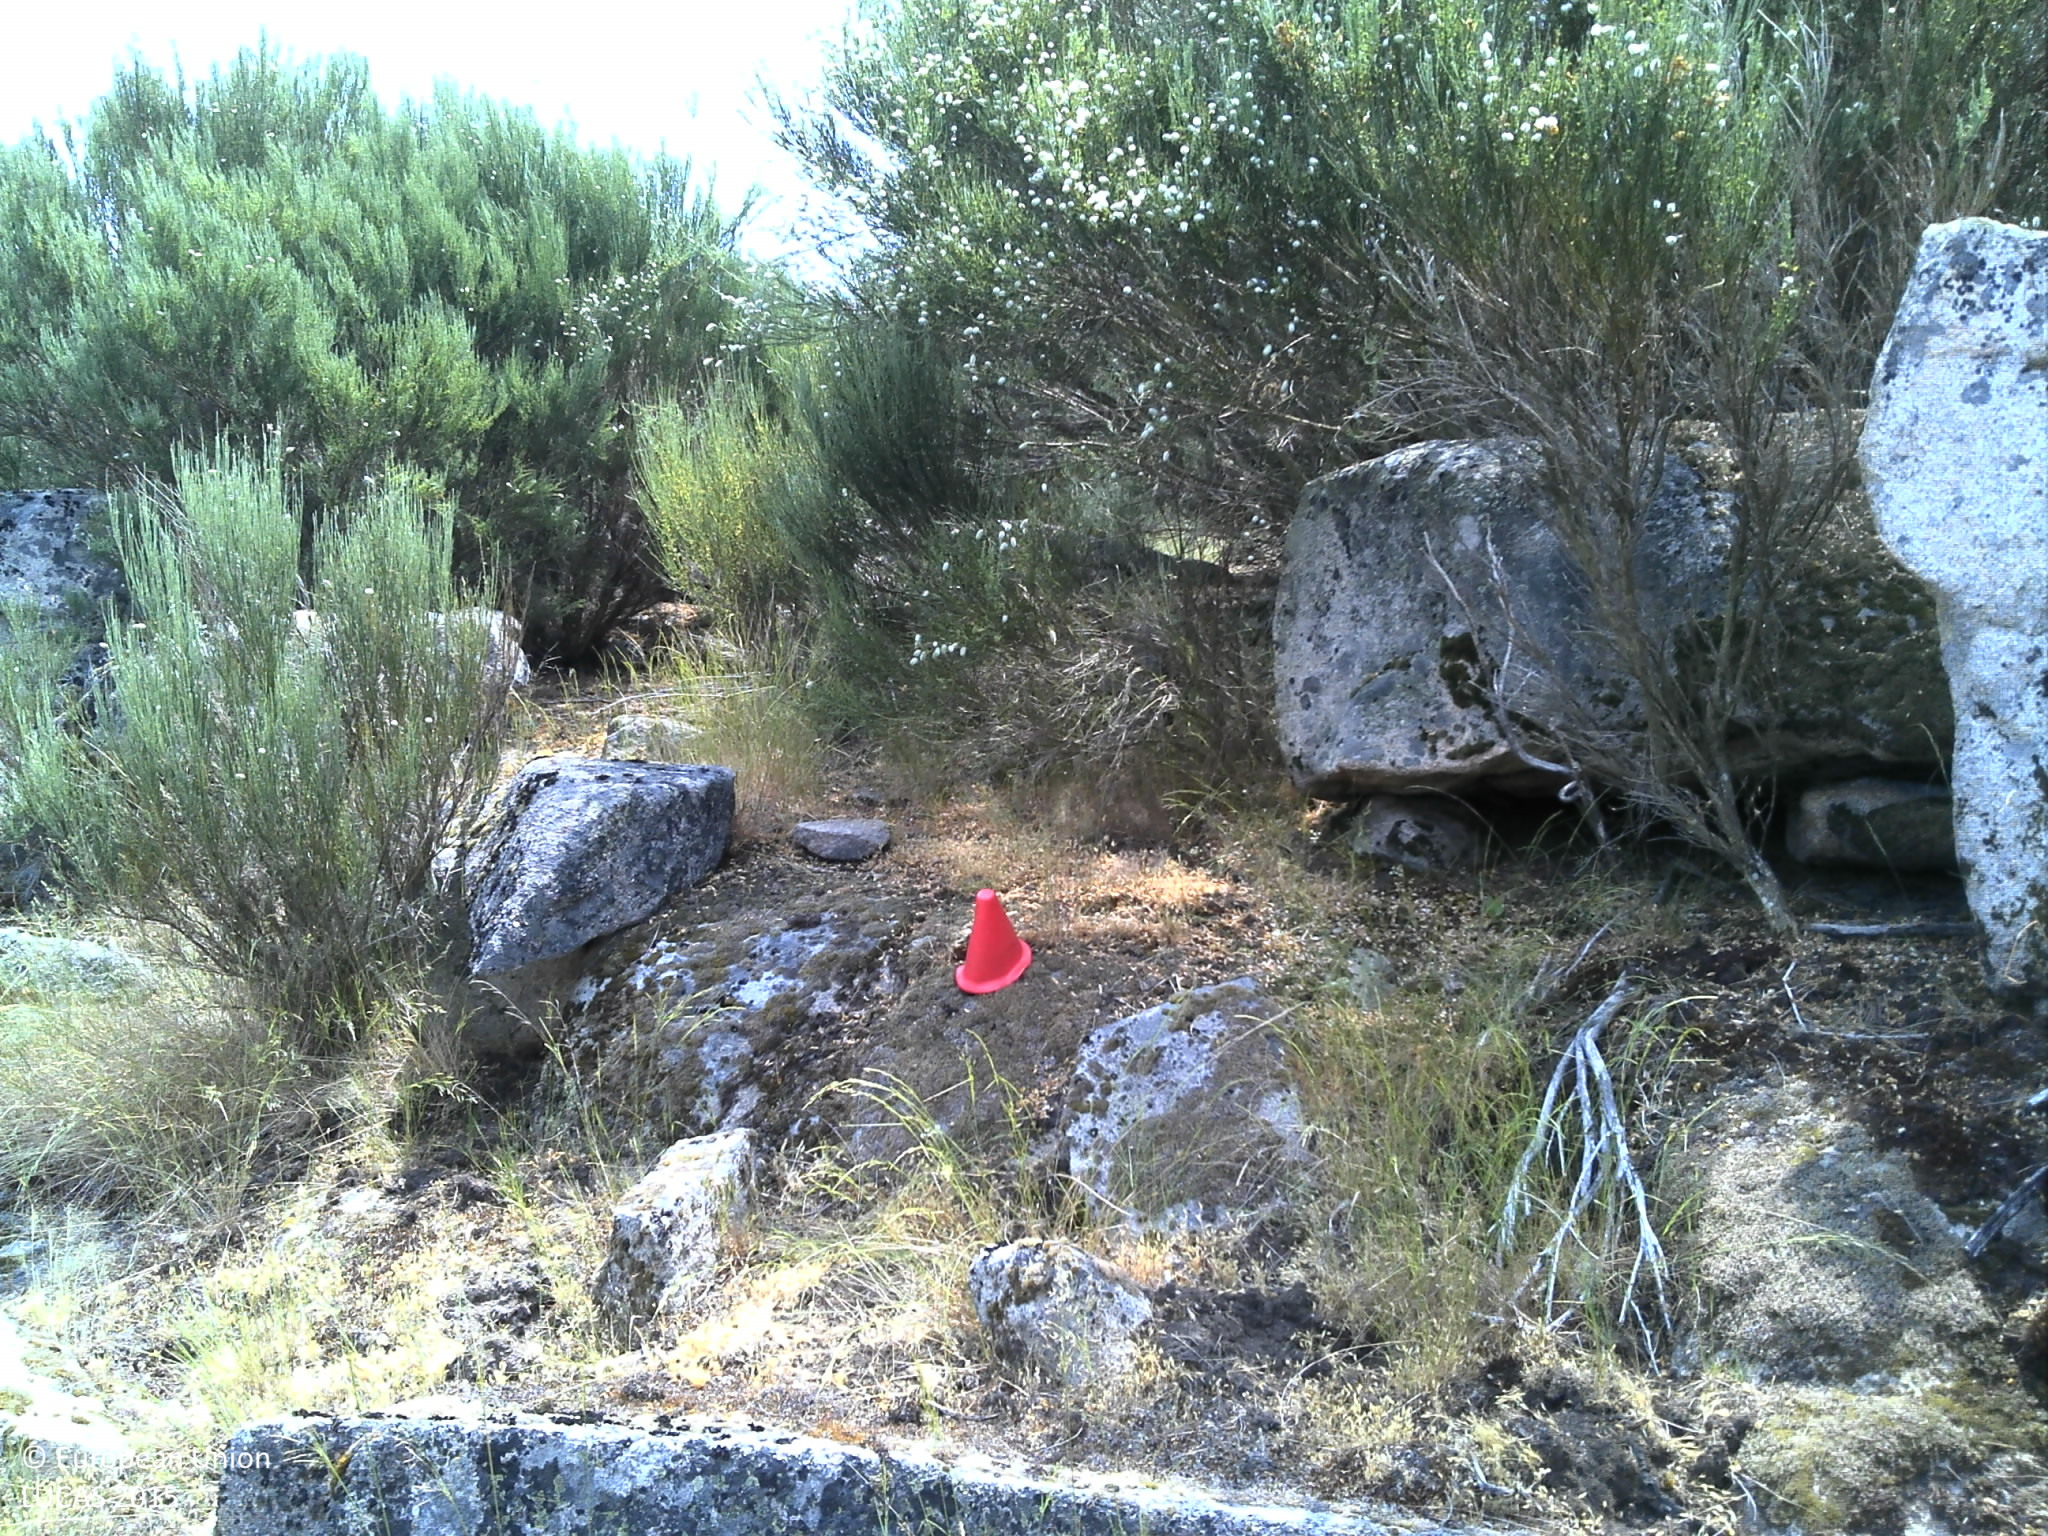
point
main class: Shrubland
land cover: Shrubland without tree cover
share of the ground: > 75 %
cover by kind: shrubs 50 %, consolidated bare surface 45 %, herbaceous plants 5 %
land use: Semi-natural and natural areas not in use
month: June
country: PT
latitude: 41.3975
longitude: -7.5782
